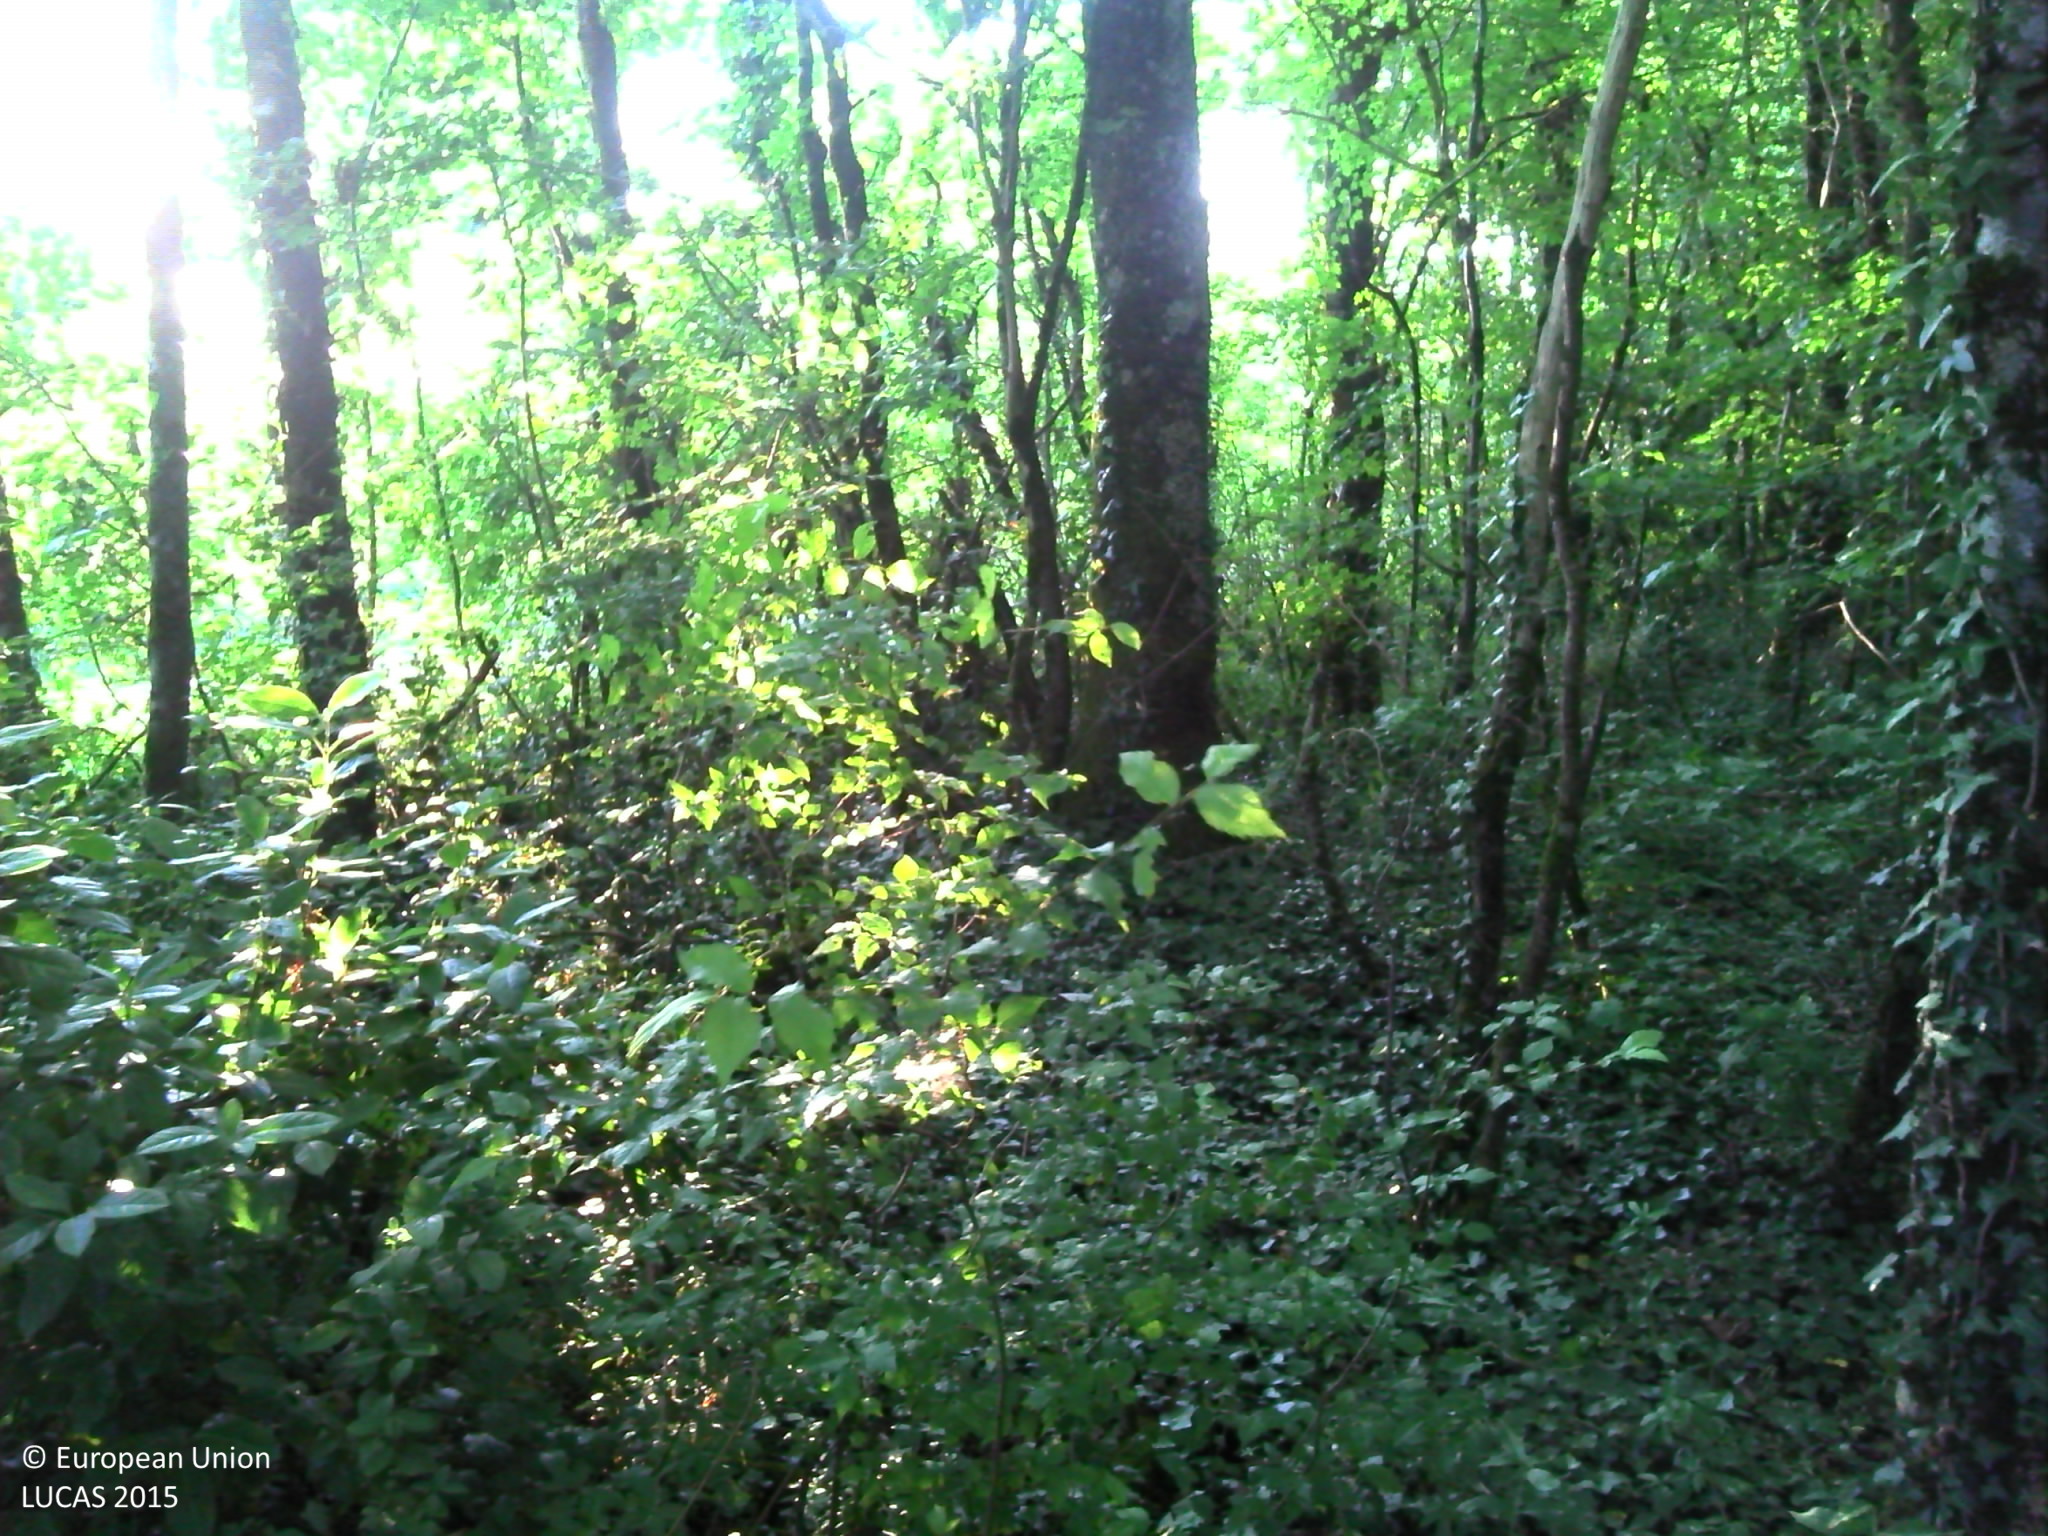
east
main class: Woodland
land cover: Broadleaved woodland
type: mesophytic deciduous forest
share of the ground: > 75 %
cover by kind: broadleaved forest trees 85 %, shrubs 10 %, herbaceous plants 5 %
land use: Forestry
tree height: > 5 m
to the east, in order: Broadleaved woodland; Ditches and canals; Grass margins; Paved roads, cycling and walking lanes; Grass margins; Electric lines; Ditches and canals; Dry stone walls; Managed hedges; Fences; Grassland without tree/shrub cover; Fences; Lines of trees; Grass margins; Tracks; Grass margins; Broadleaved woodland
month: June
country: FR
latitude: 46.6781
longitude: 0.5830
